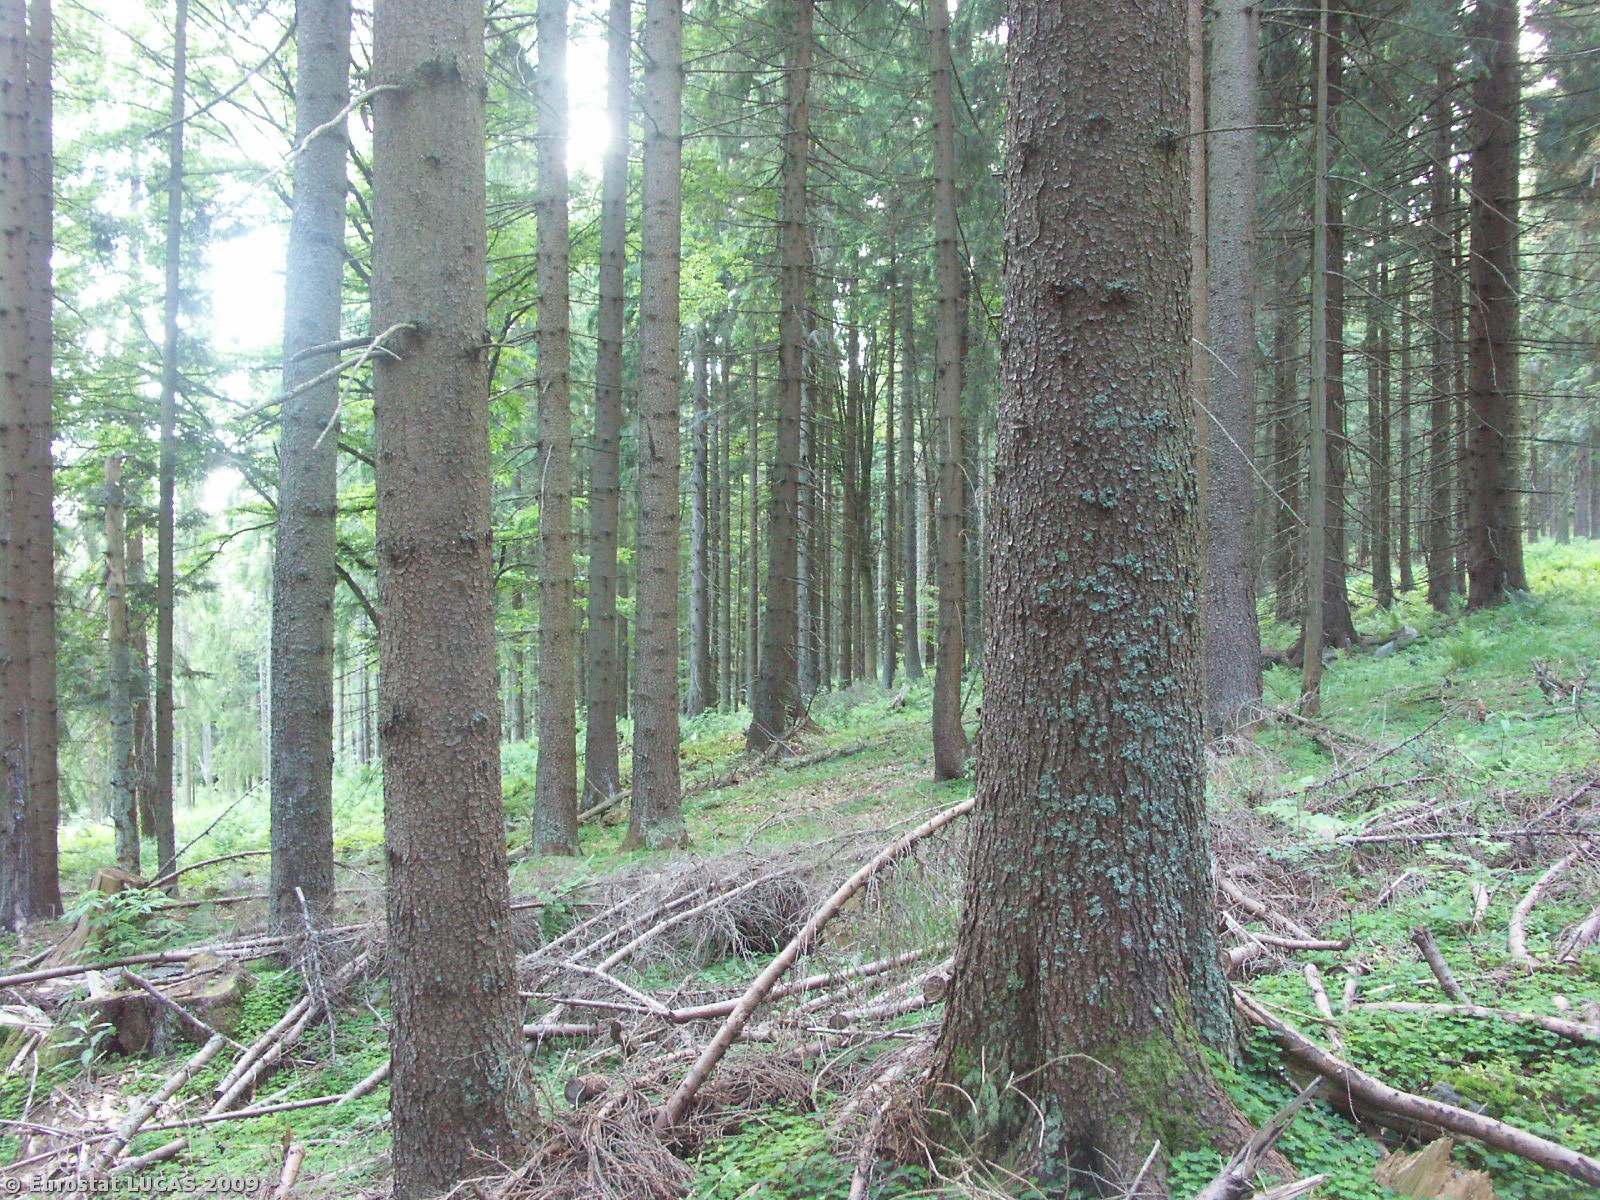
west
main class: Woodland
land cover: Coniferous woodland
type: hemiboreal forest and nemoral coniferous forest and mixed broadleaved-coniferous forest
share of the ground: > 75 %
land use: Forestry
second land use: Nature reserves
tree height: > 5 m
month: June
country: CZ
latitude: 48.8737
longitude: 13.9406
